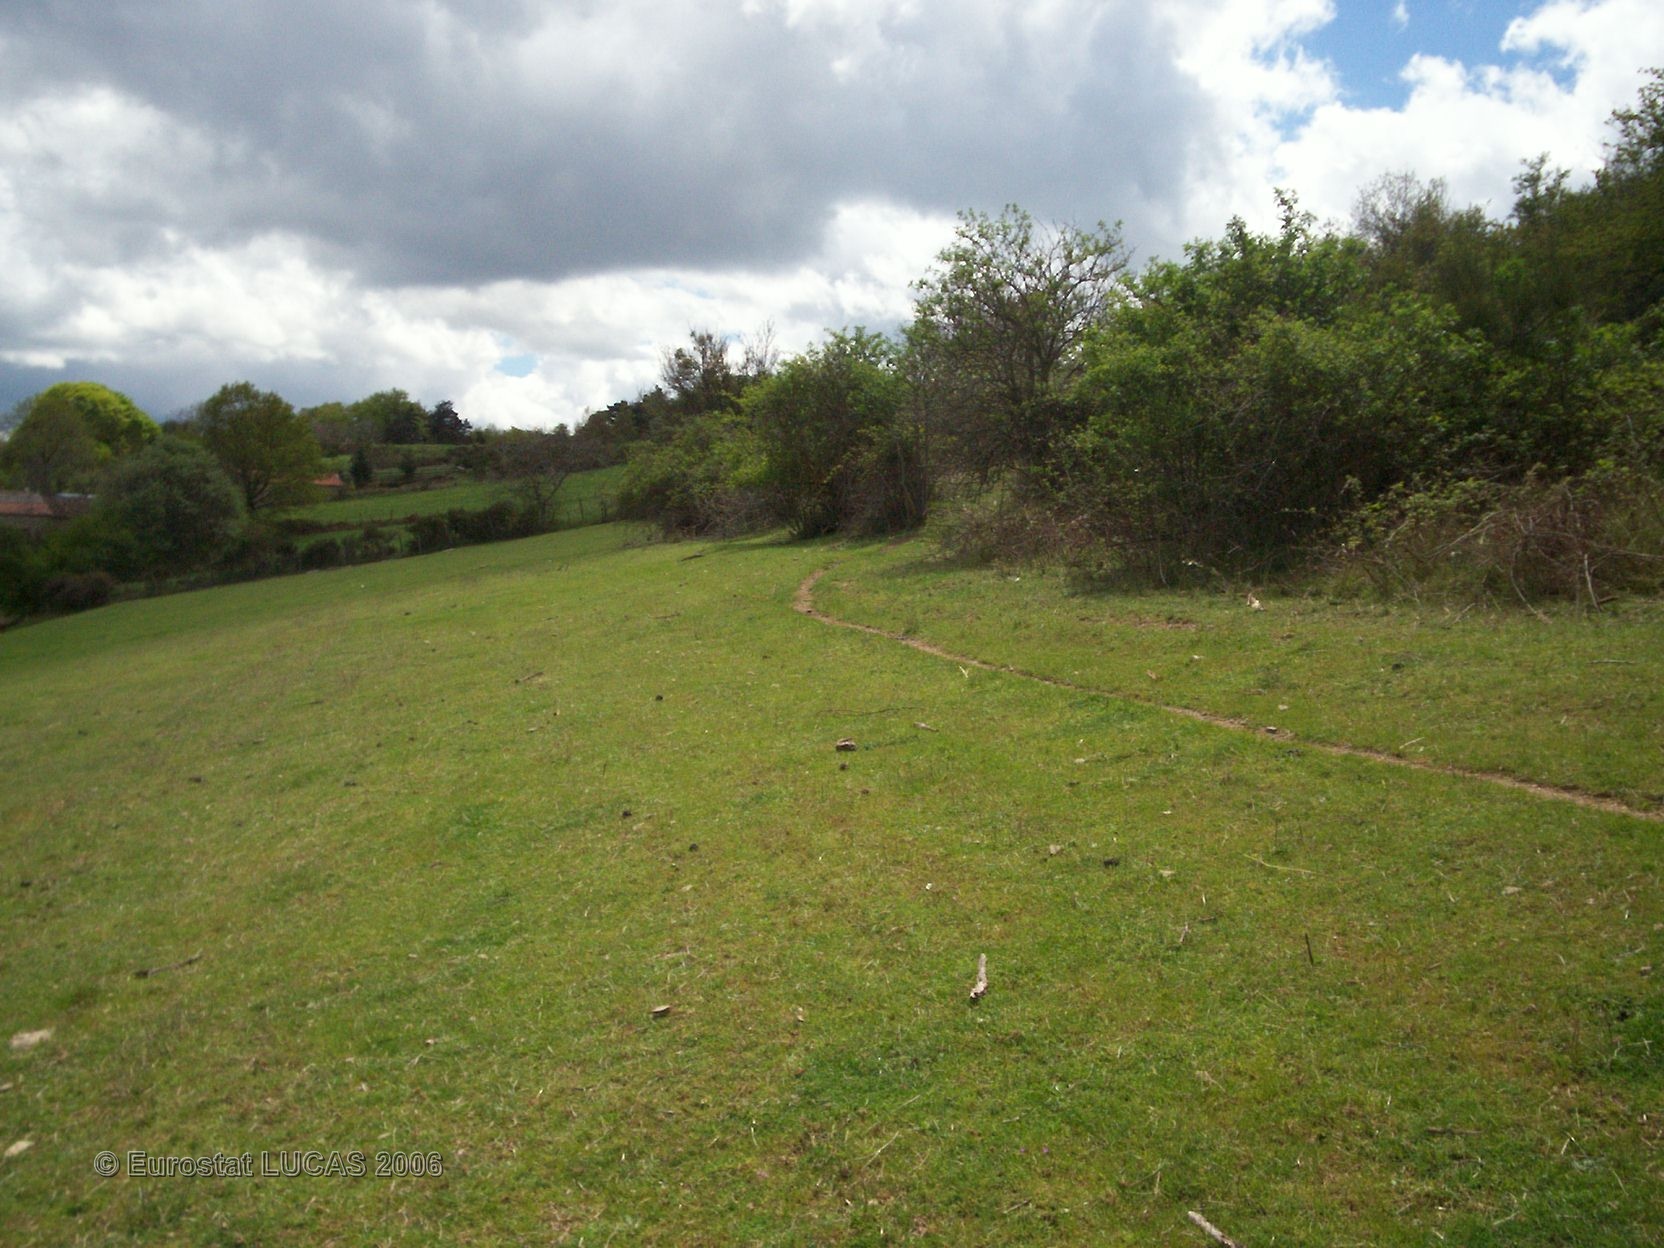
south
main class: Grassland
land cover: Grassland without tree/shrub cover
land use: Agriculture (excluding fallow land and kitchen gardens)
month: May
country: FR
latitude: 45.2023
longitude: 3.3187
